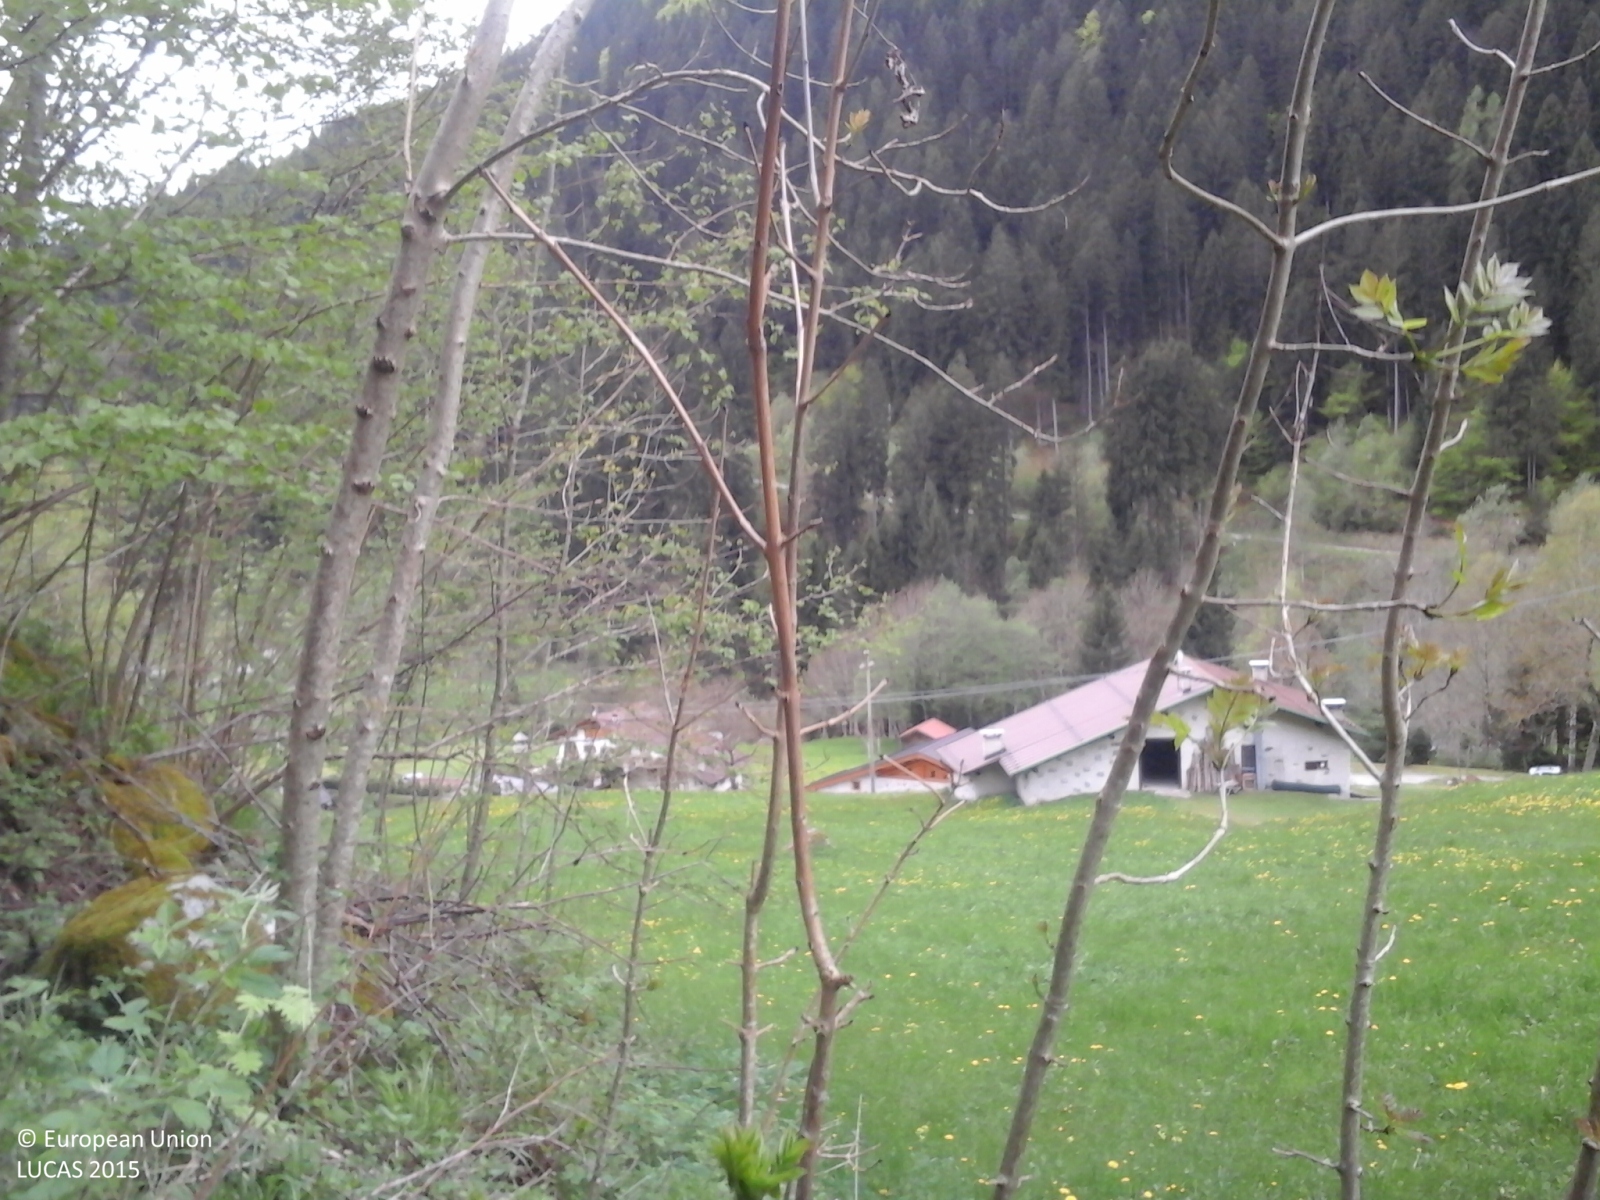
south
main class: Woodland
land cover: Spruce dominated coniferous woodland
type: alpine coniferous forest
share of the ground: > 75 %
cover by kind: coniferous forest trees 90 %, broadleaved forest trees 10 %
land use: Forestry
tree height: > 5 m
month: May
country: IT
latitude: 46.0249
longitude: 10.6579
